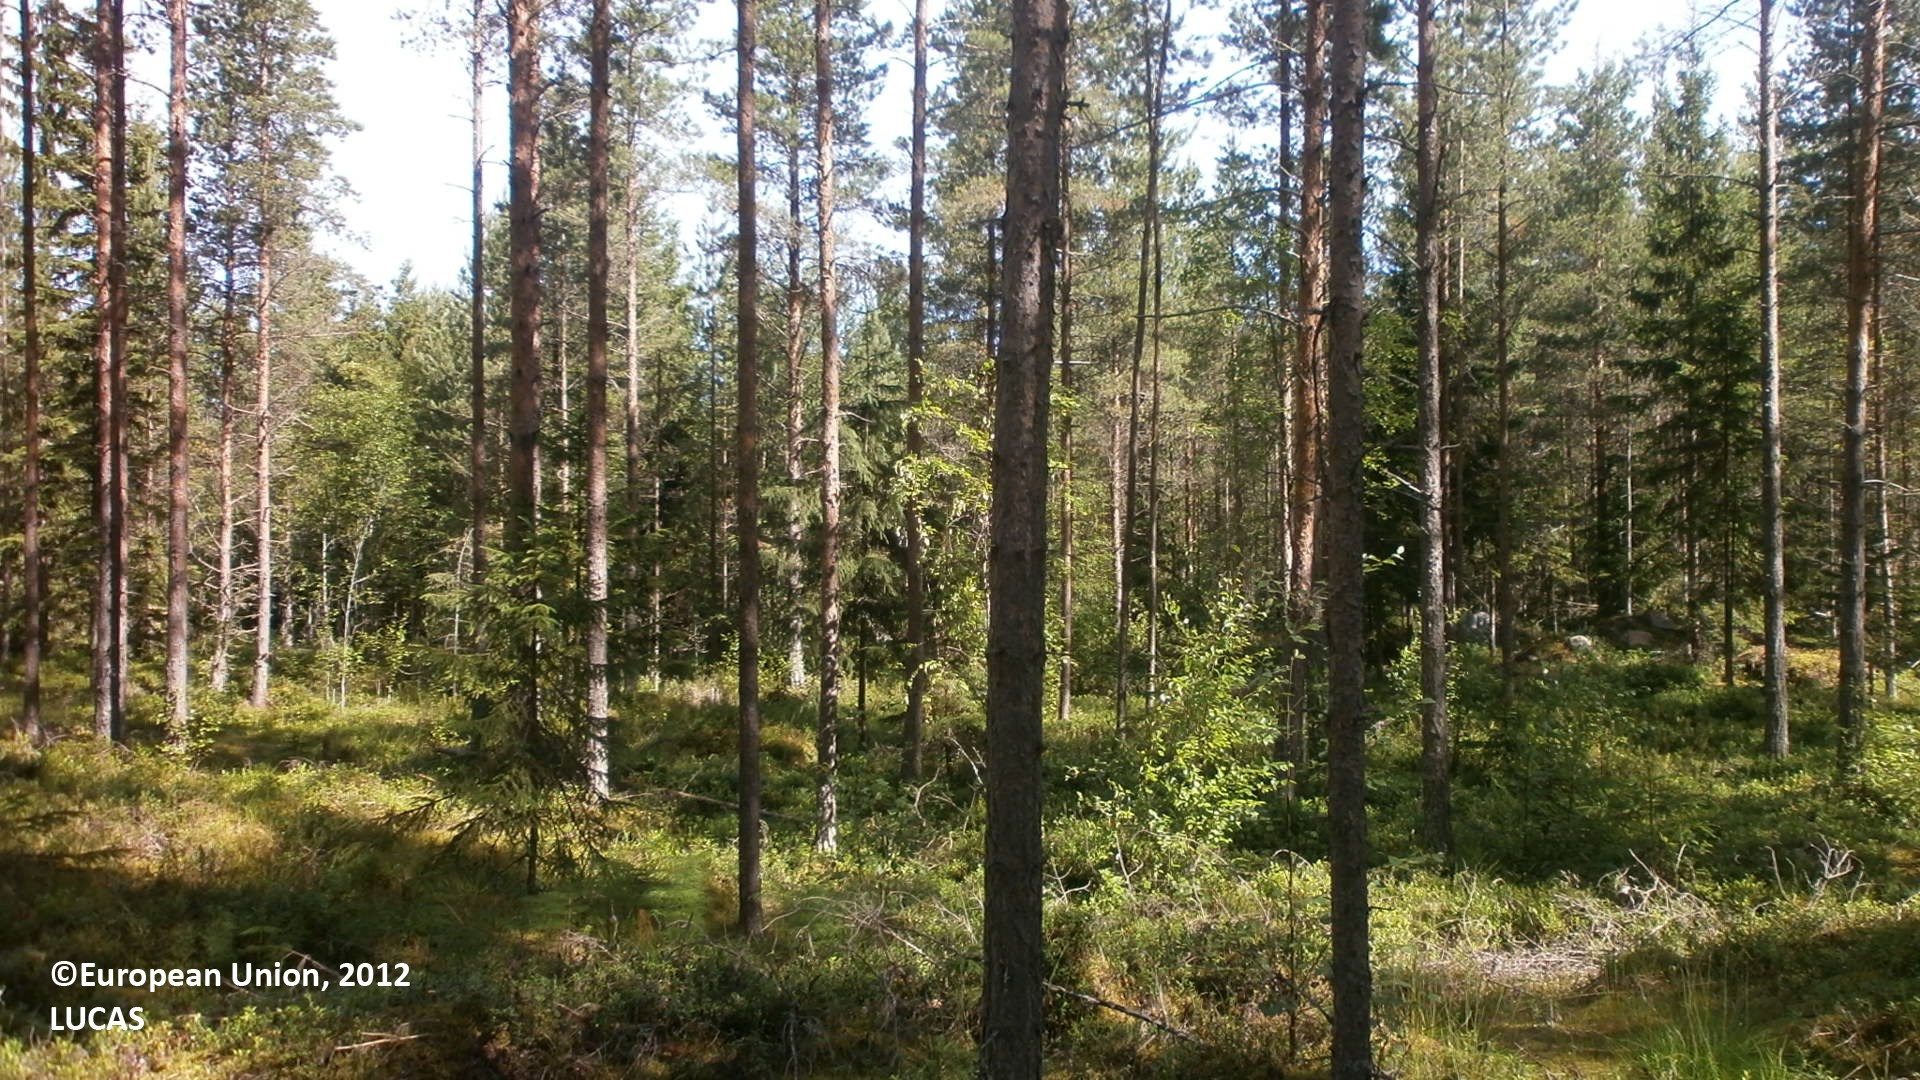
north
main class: Woodland
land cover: Pine dominated coniferous woodland
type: boreal forest
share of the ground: 50 - 75 %
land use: Forestry
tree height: > 5 m
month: July
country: FI
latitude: 64.3867
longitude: 24.1413
